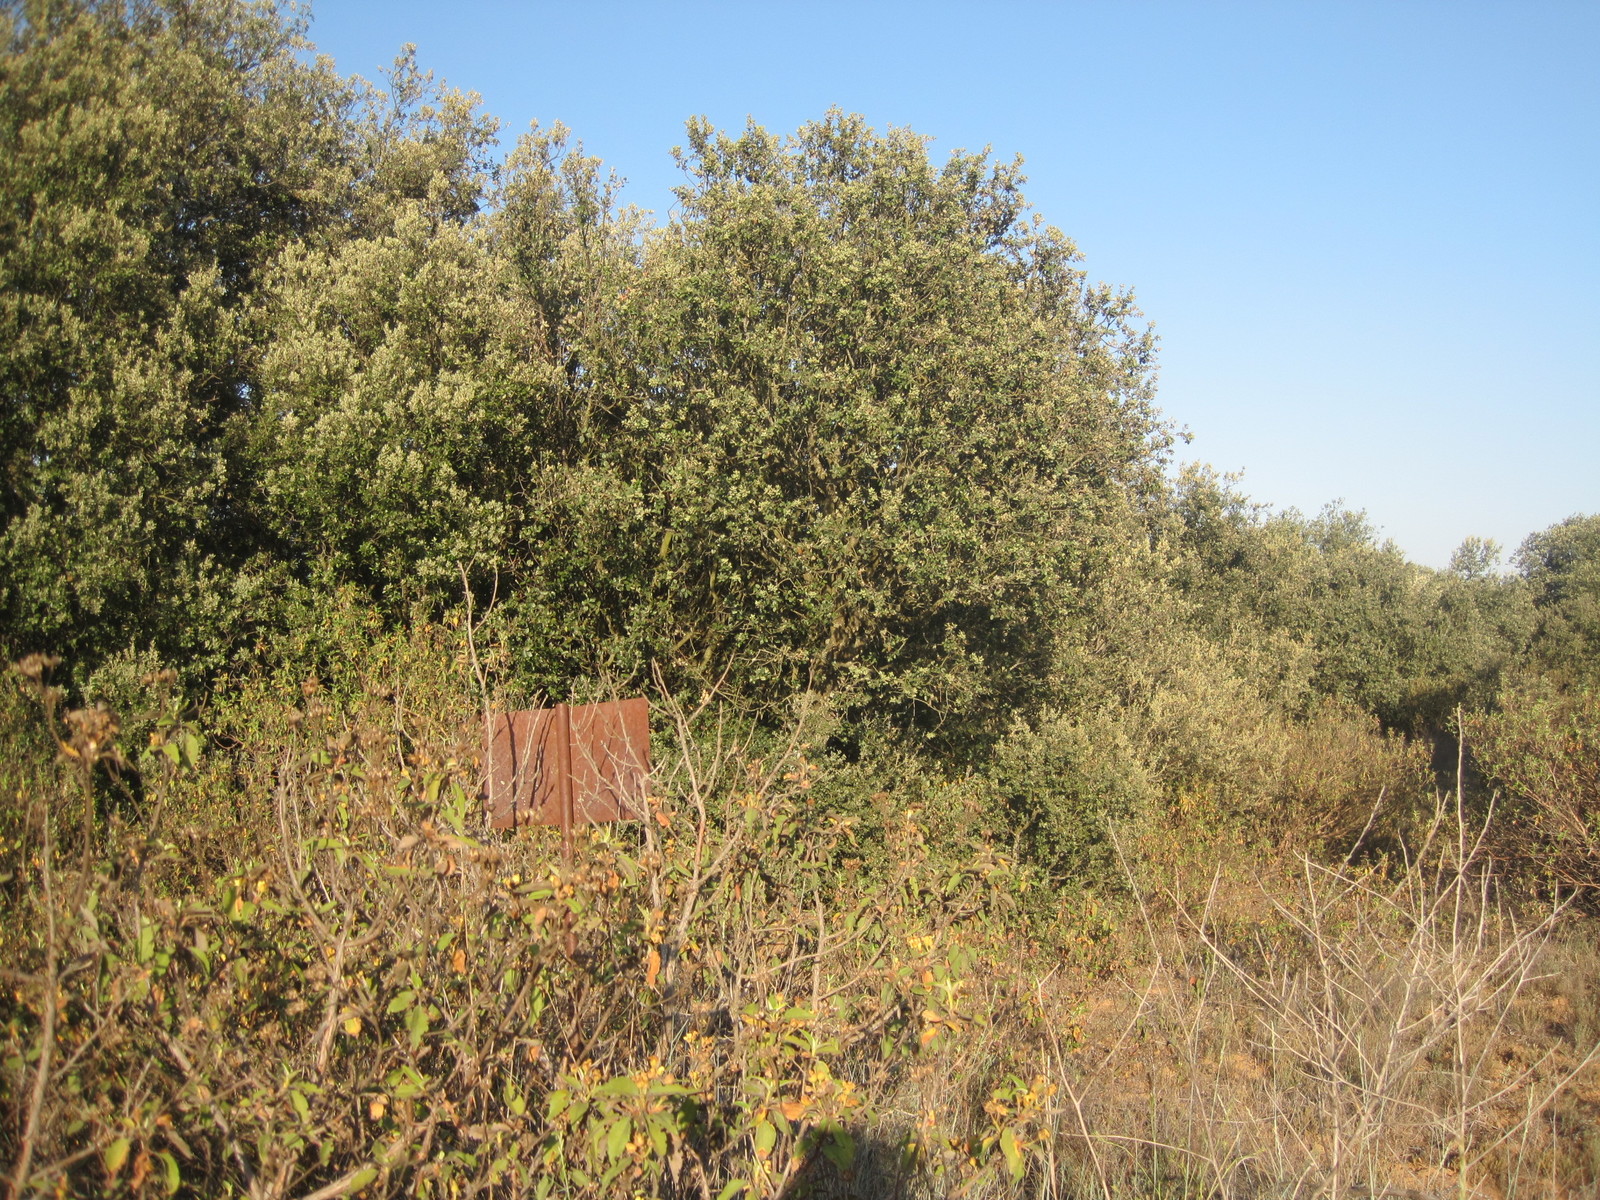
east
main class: Grassland
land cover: Grassland without tree/shrub cover
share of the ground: > 75 %
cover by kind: herbaceous plants 100 %
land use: Semi-natural and natural areas not in use
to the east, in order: Grassland without tree/shrub cover; Broadleaved woodland
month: July
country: ES
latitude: 41.7107
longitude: -5.1365
